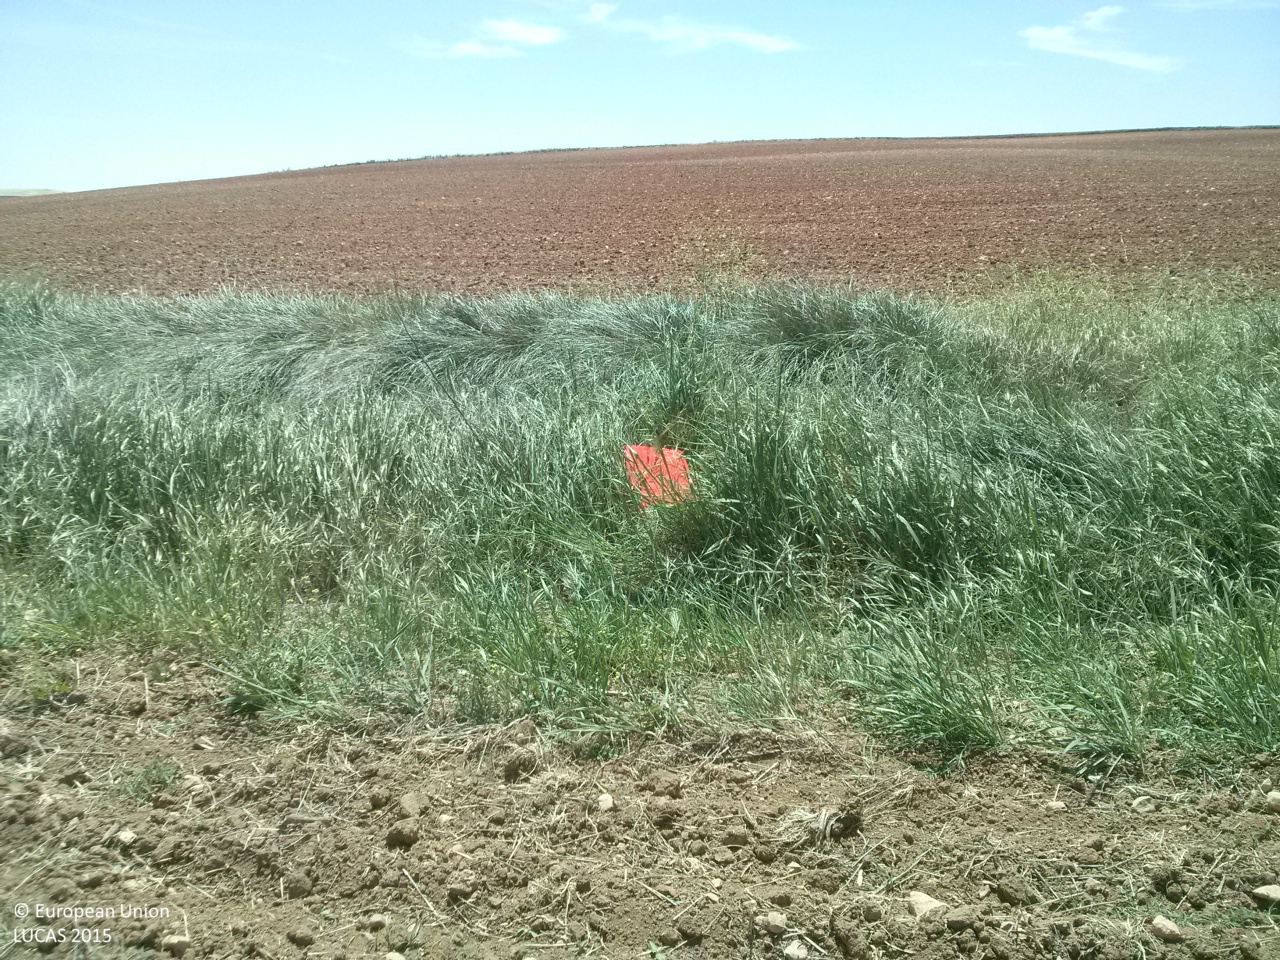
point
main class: Cropland
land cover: Sunflower
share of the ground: < 10 %
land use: Agriculture (excluding fallow land and kitchen gardens)
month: May
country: ES
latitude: 40.1201
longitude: -2.8011
